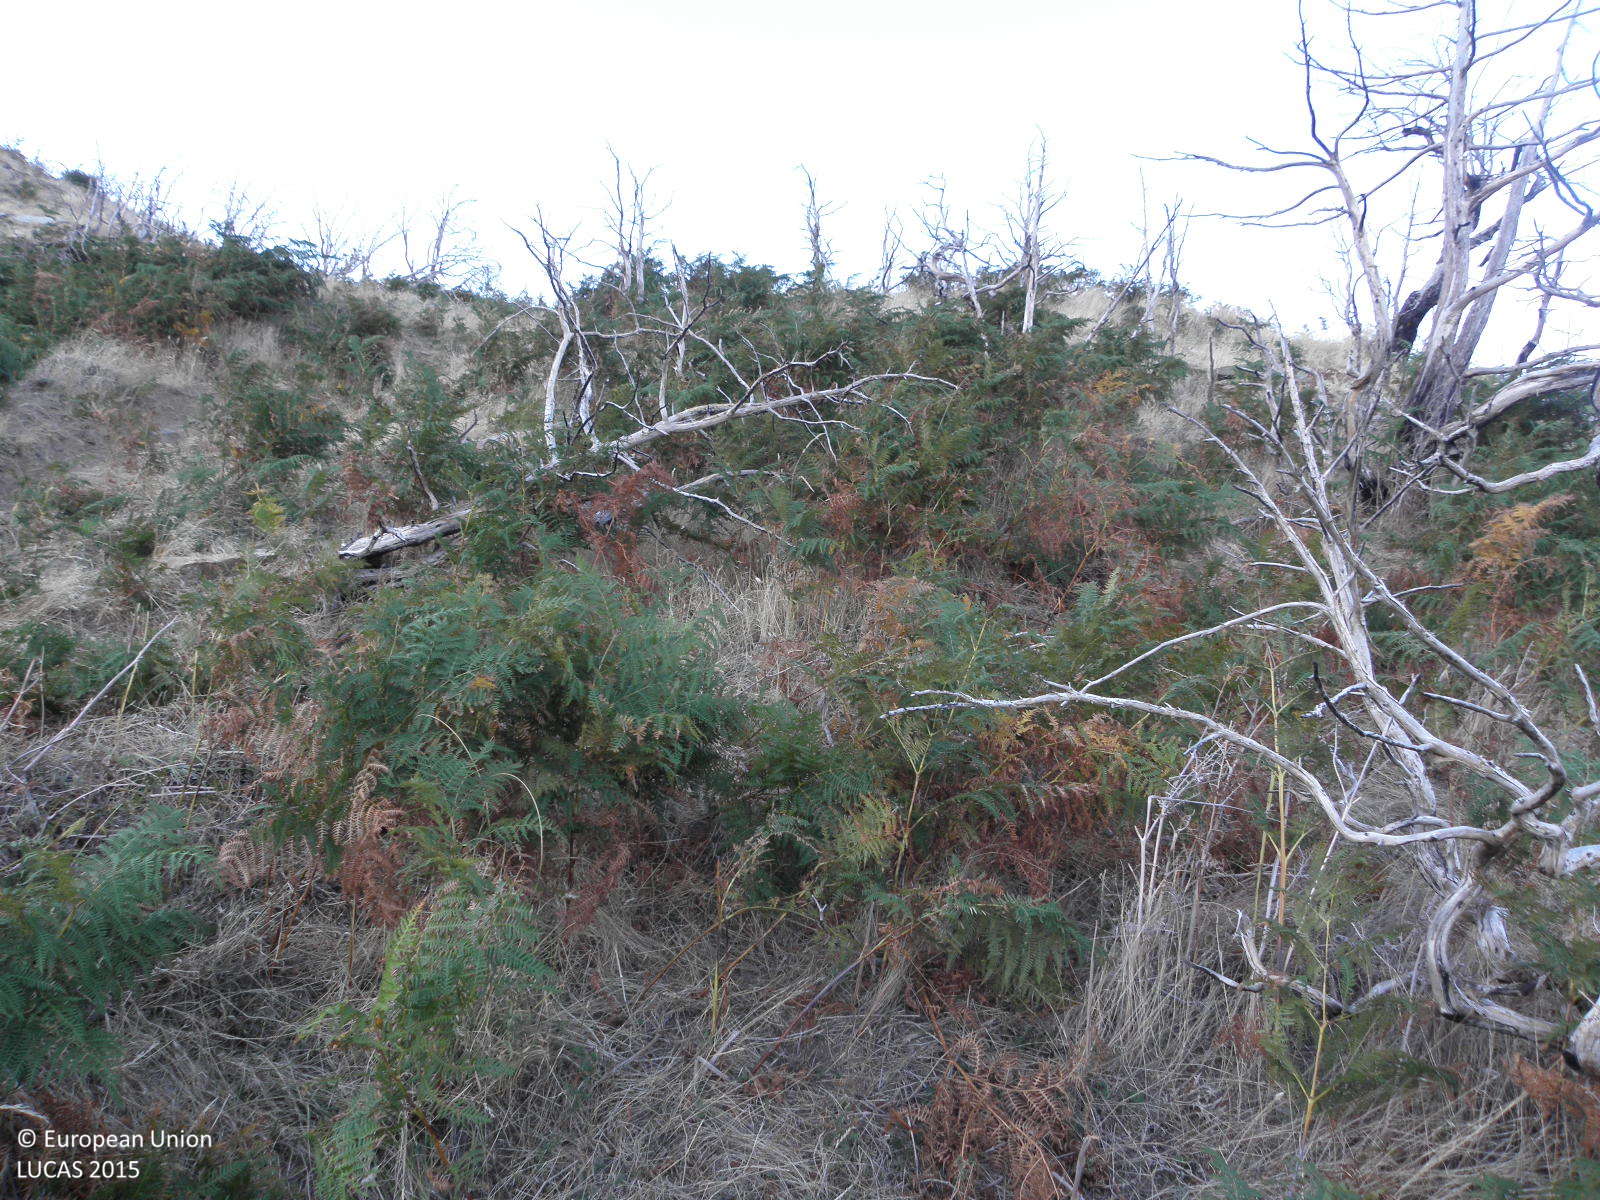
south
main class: Grassland
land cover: Grassland without tree/shrub cover
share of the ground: > 75 %
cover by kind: herbaceous plants 95 %, shrubs 5 %
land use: Agriculture (excluding fallow land and kitchen gardens)
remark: Burnt area
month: September
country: GR
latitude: 39.8412
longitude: 22.5563
